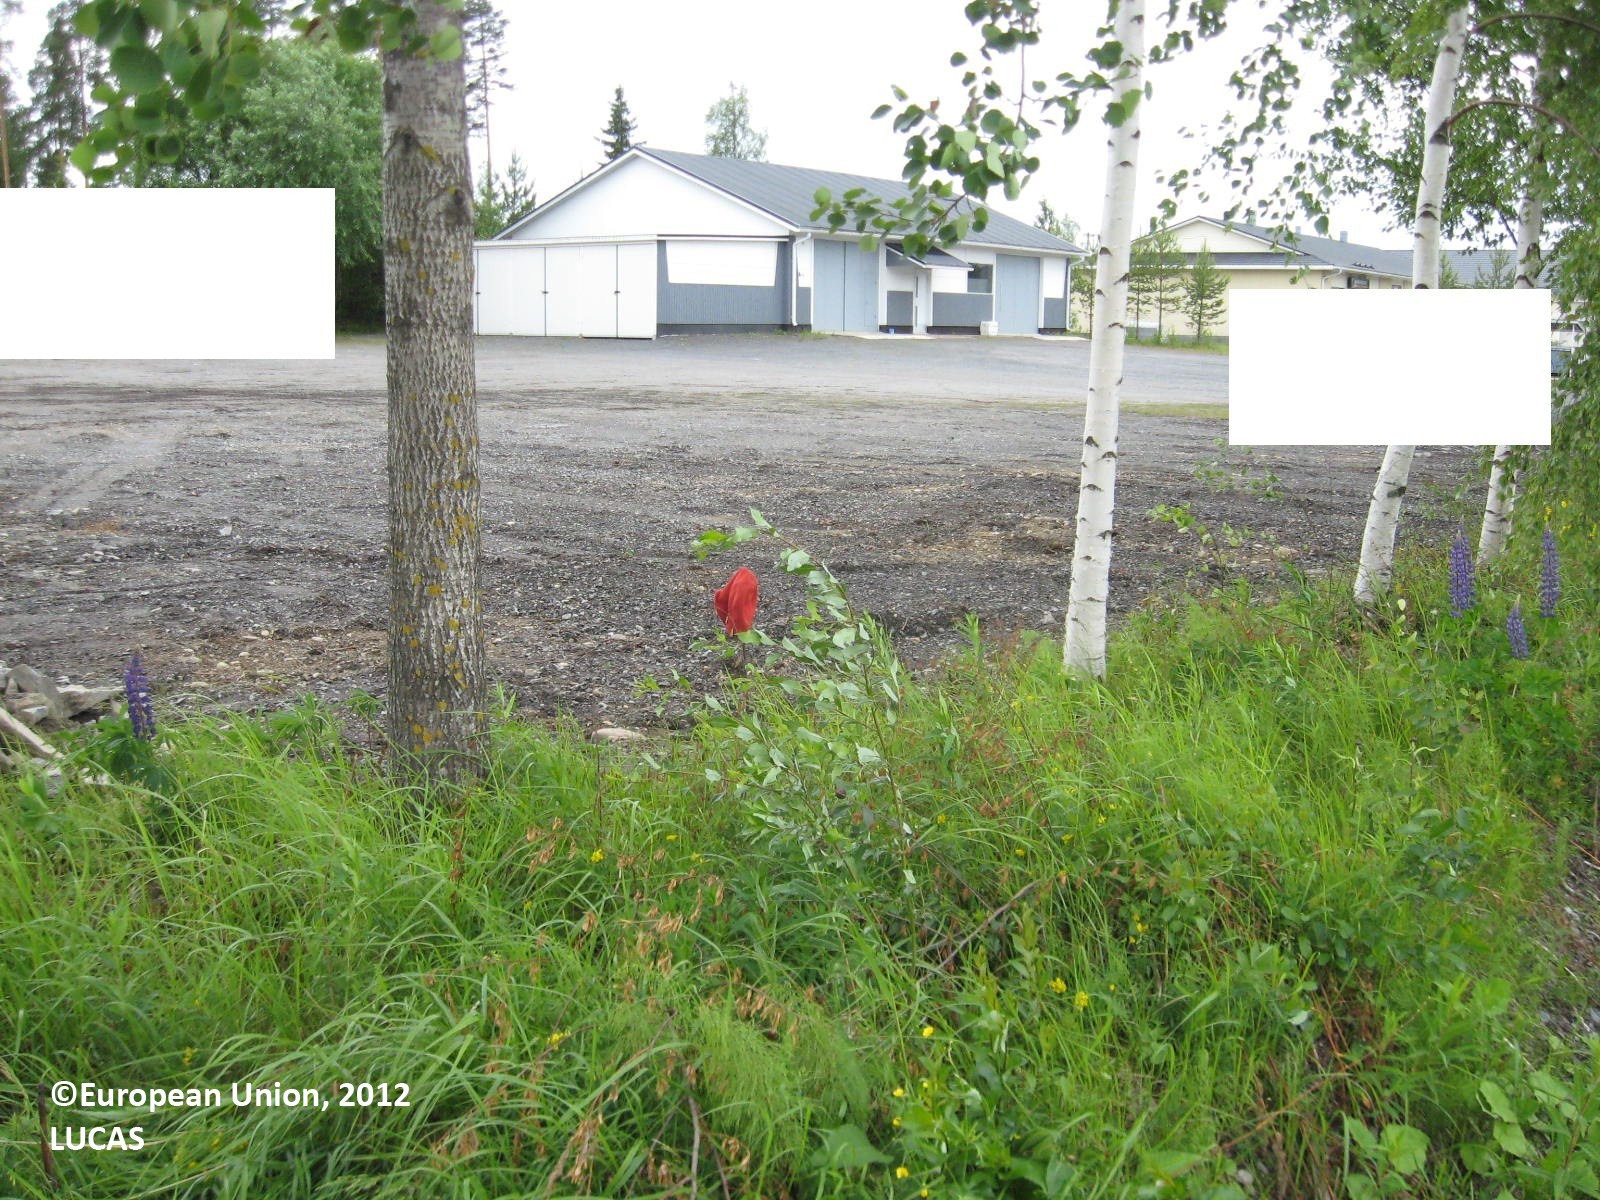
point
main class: Woodland
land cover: Broadleaved woodland
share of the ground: > 75 %
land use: Commerce, finance, business
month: June
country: FI
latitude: 62.7875
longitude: 22.8980
